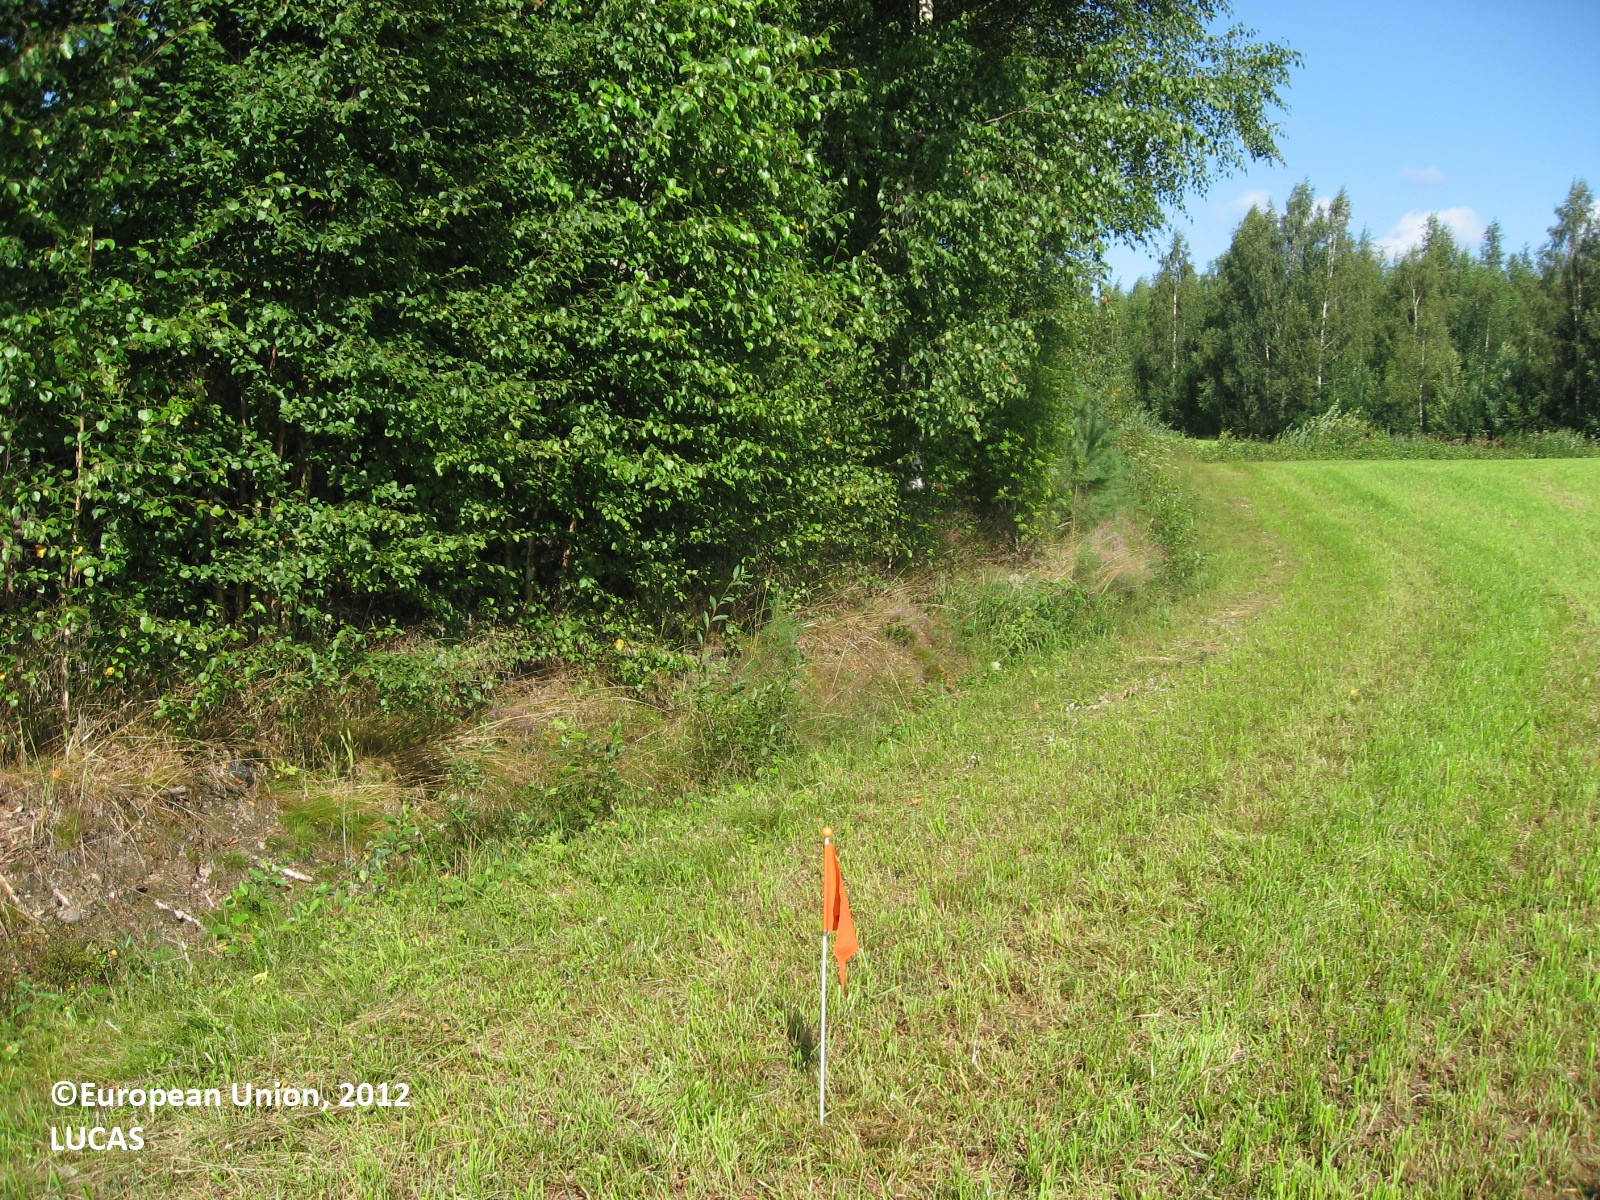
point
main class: Cropland
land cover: Temporary grasslands
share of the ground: > 75 %
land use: Agriculture (excluding fallow land and kitchen gardens)
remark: Harvested field
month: July
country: FI
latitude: 61.2837
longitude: 26.5123
